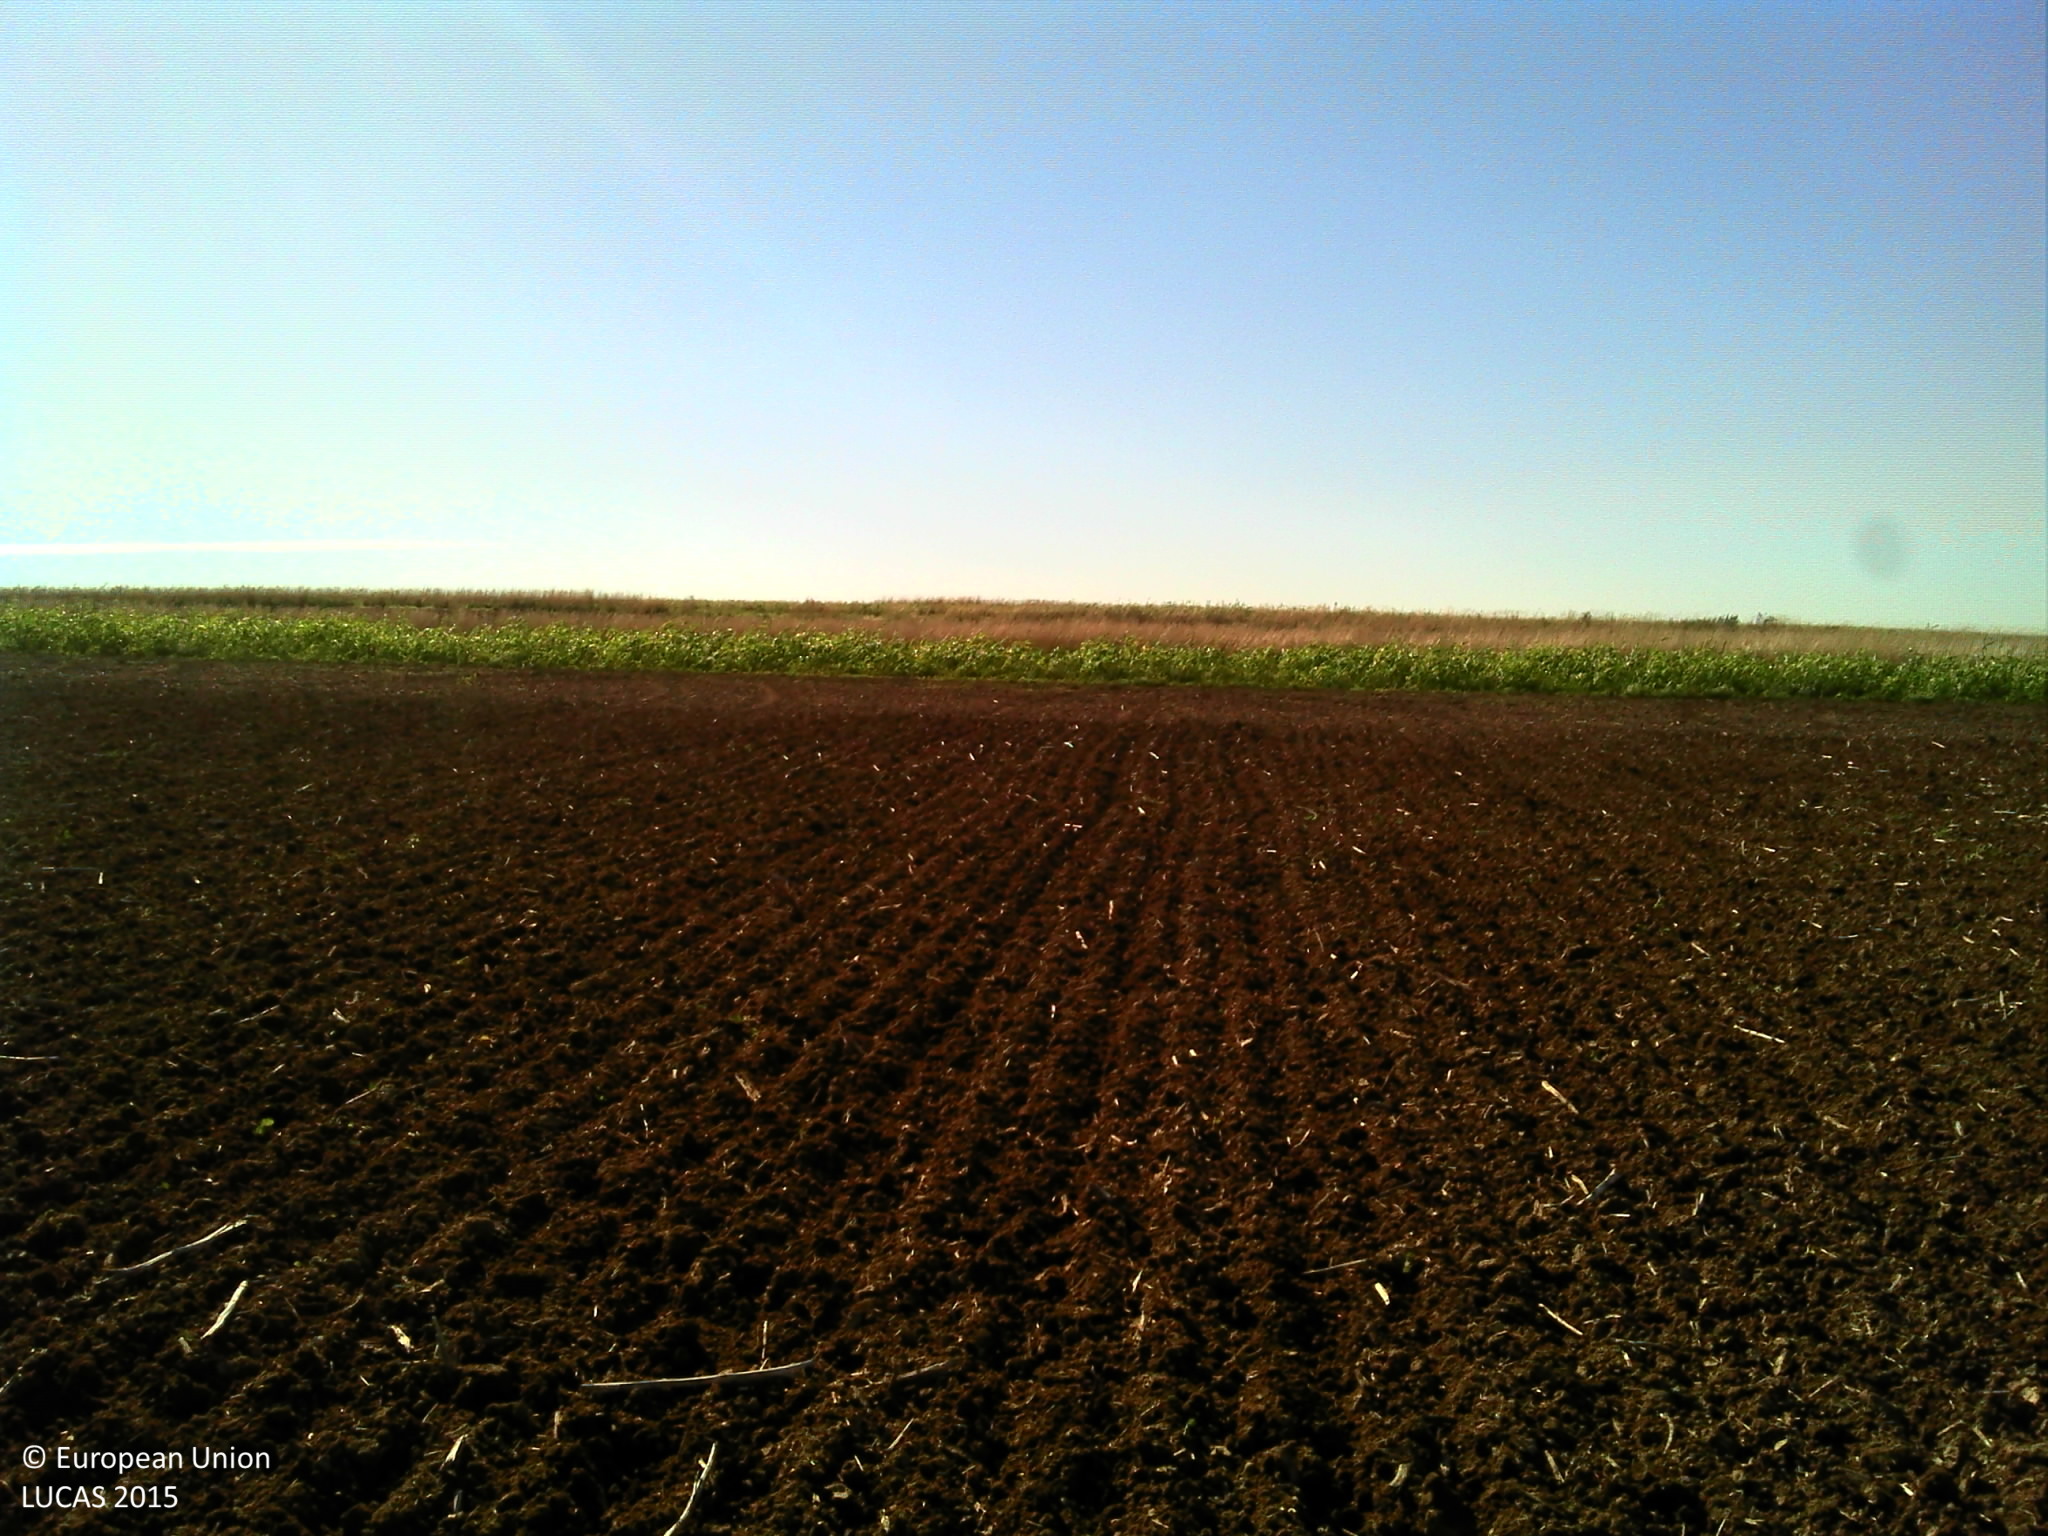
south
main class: Cropland
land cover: Rape and turnip rape
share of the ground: < 10 %
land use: Agriculture (excluding fallow land and kitchen gardens)
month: September
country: FR
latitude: 48.4025
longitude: 3.3613
